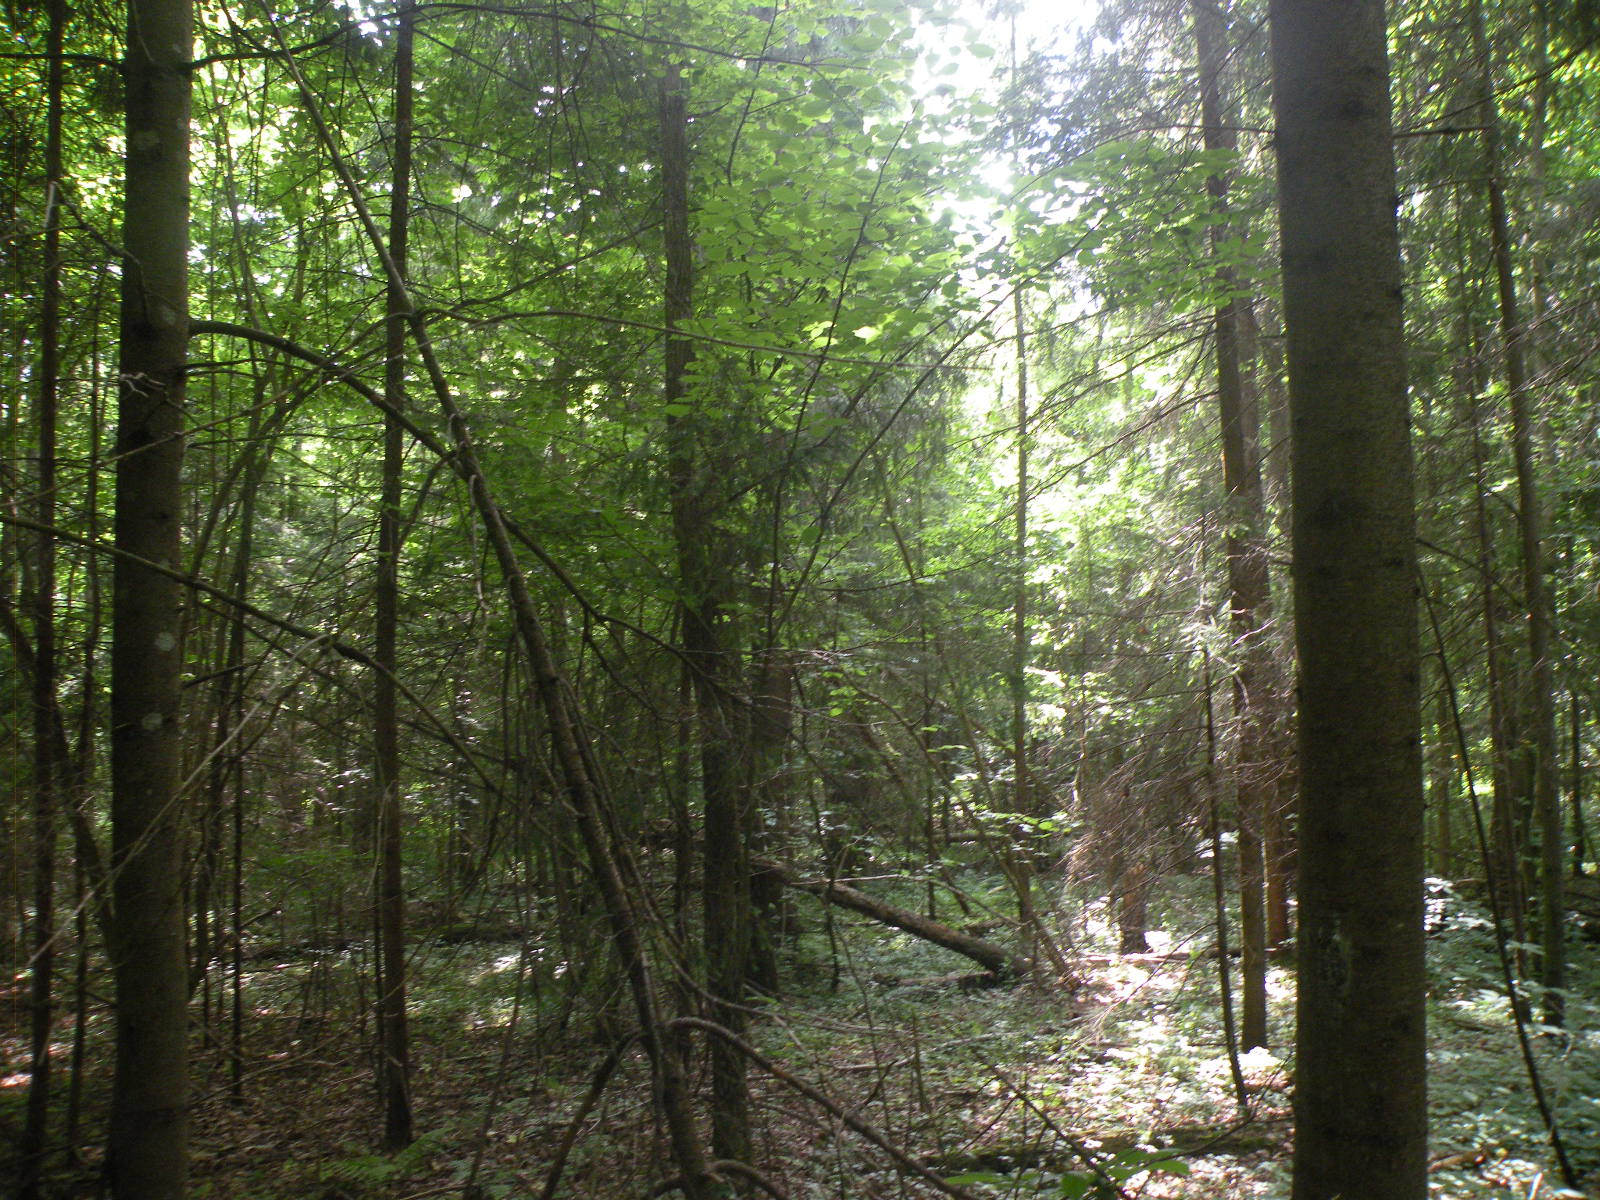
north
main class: Woodland
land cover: Spruce dominated mixed woodland
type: hemiboreal forest and nemoral coniferous forest and mixed broadleaved-coniferous forest
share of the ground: > 75 %
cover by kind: coniferous forest trees 45 %, broadleaved forest trees 30 %, herbaceous plants 15 %, shrubs 5 %
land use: Forestry
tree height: > 5 m
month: June
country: LV
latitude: 55.9430
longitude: 26.7288
